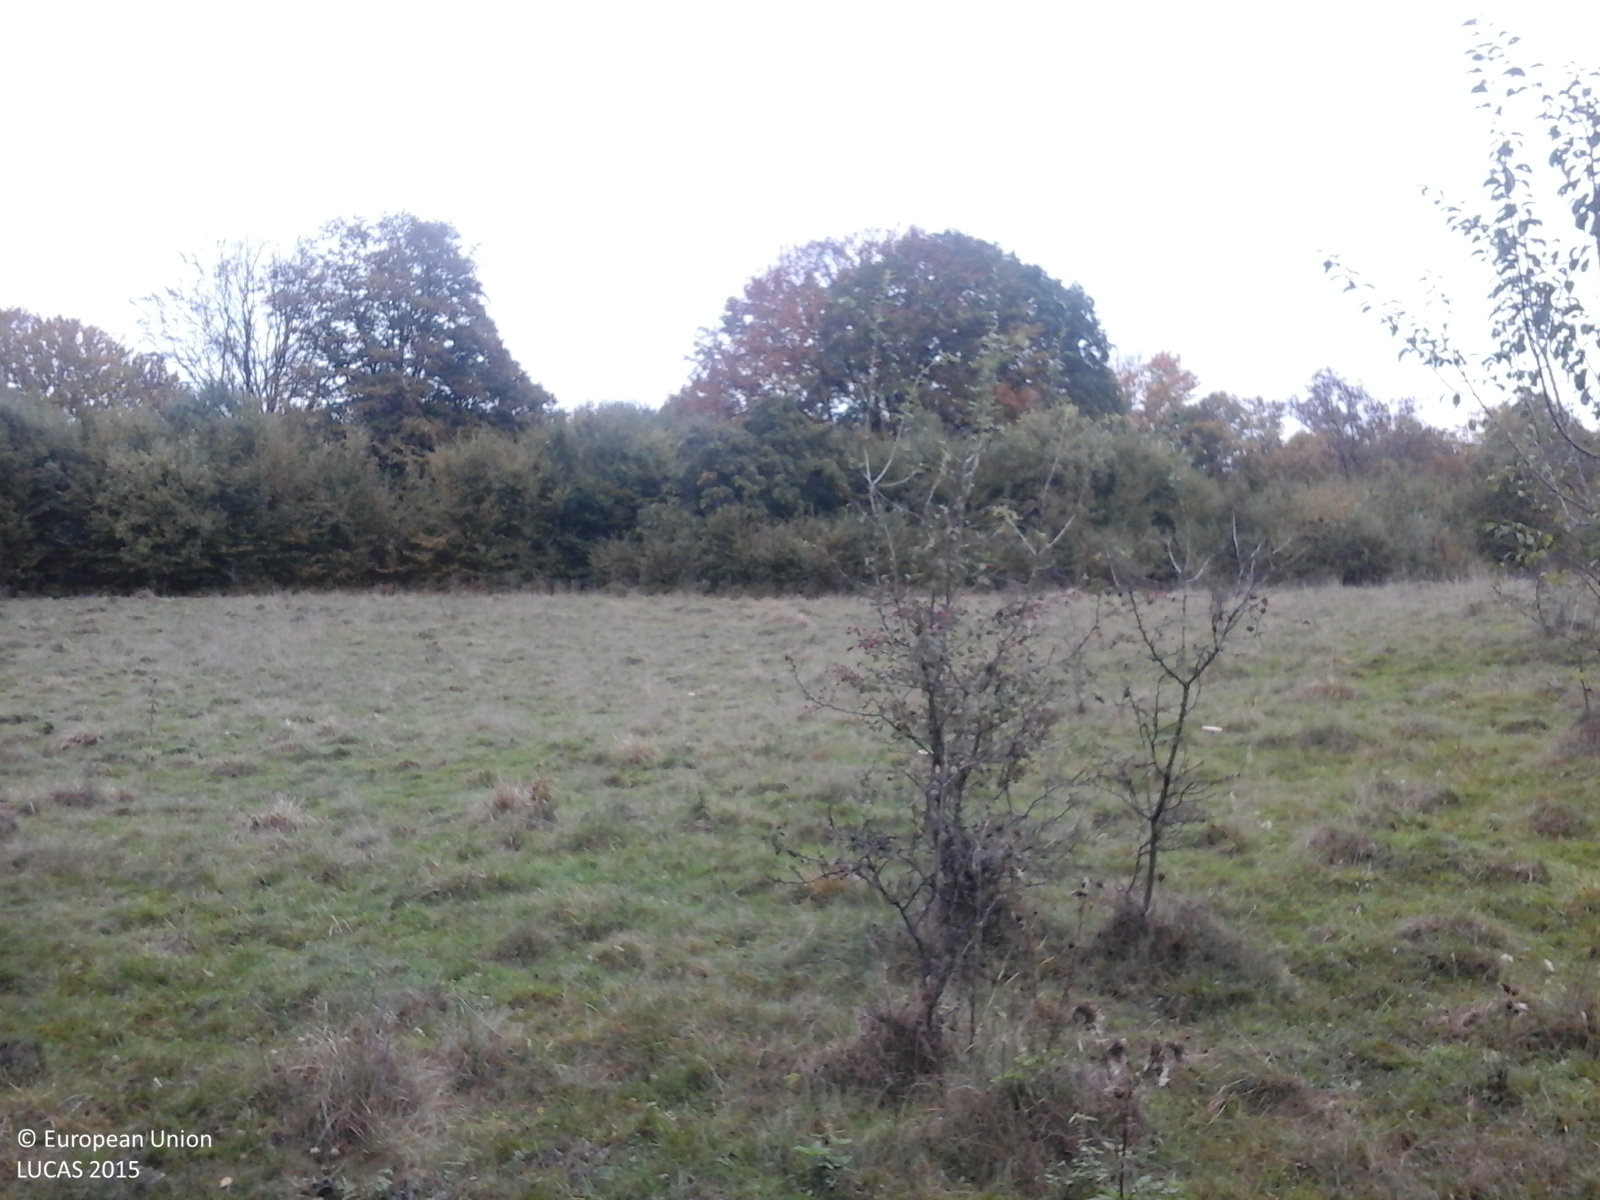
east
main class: Grassland
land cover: Grassland with sparse tree/shrub cover
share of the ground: > 75 %
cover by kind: herbaceous plants 85 %, shrubs 10 %, broadleaved forest trees 5 %
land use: Fallow land
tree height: < 5 m
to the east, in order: Grassland with sparse tree/shrub cover; Broadleaved woodland; Grassland with sparse tree/shrub cover; Broadleaved woodland
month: October
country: RO
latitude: 45.9503
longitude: 24.7037
